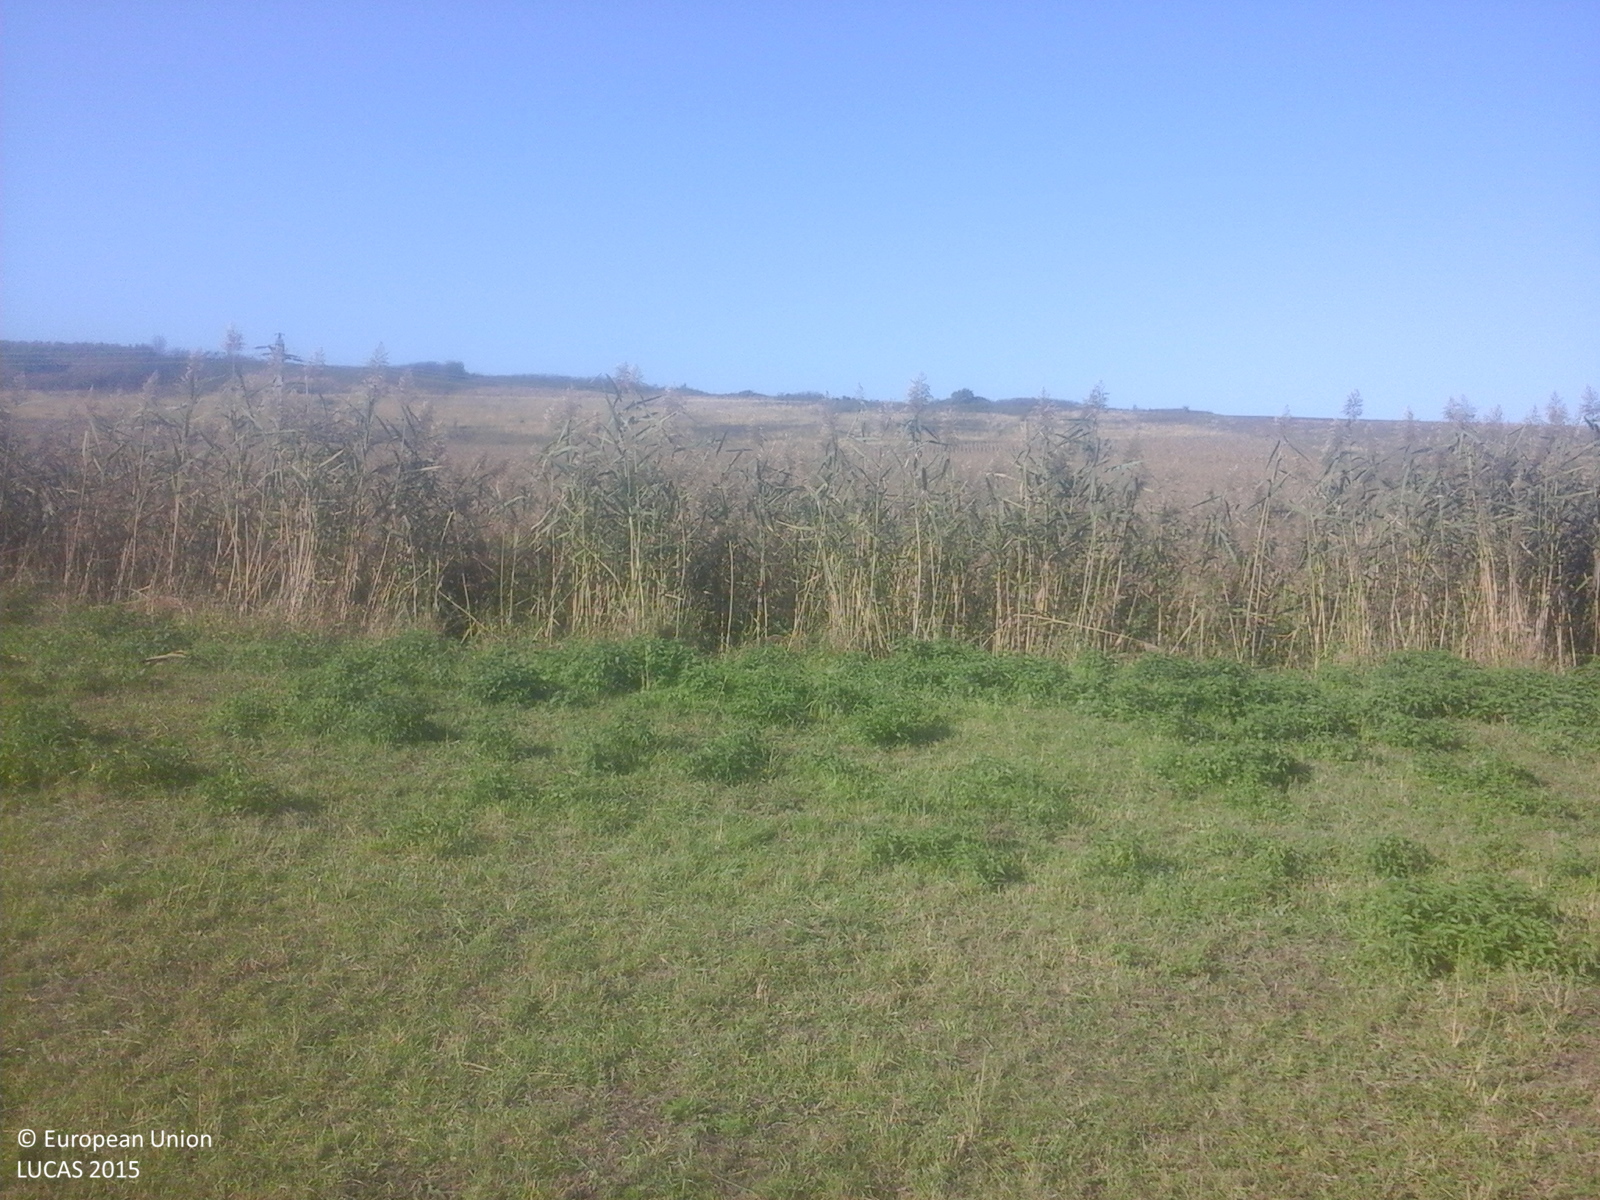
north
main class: Grassland
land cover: Grassland without tree/shrub cover
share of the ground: > 75 %
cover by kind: herbaceous plants 100 %
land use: Agriculture (excluding fallow land and kitchen gardens)
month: October
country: RO
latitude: 45.9311
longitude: 24.0406
